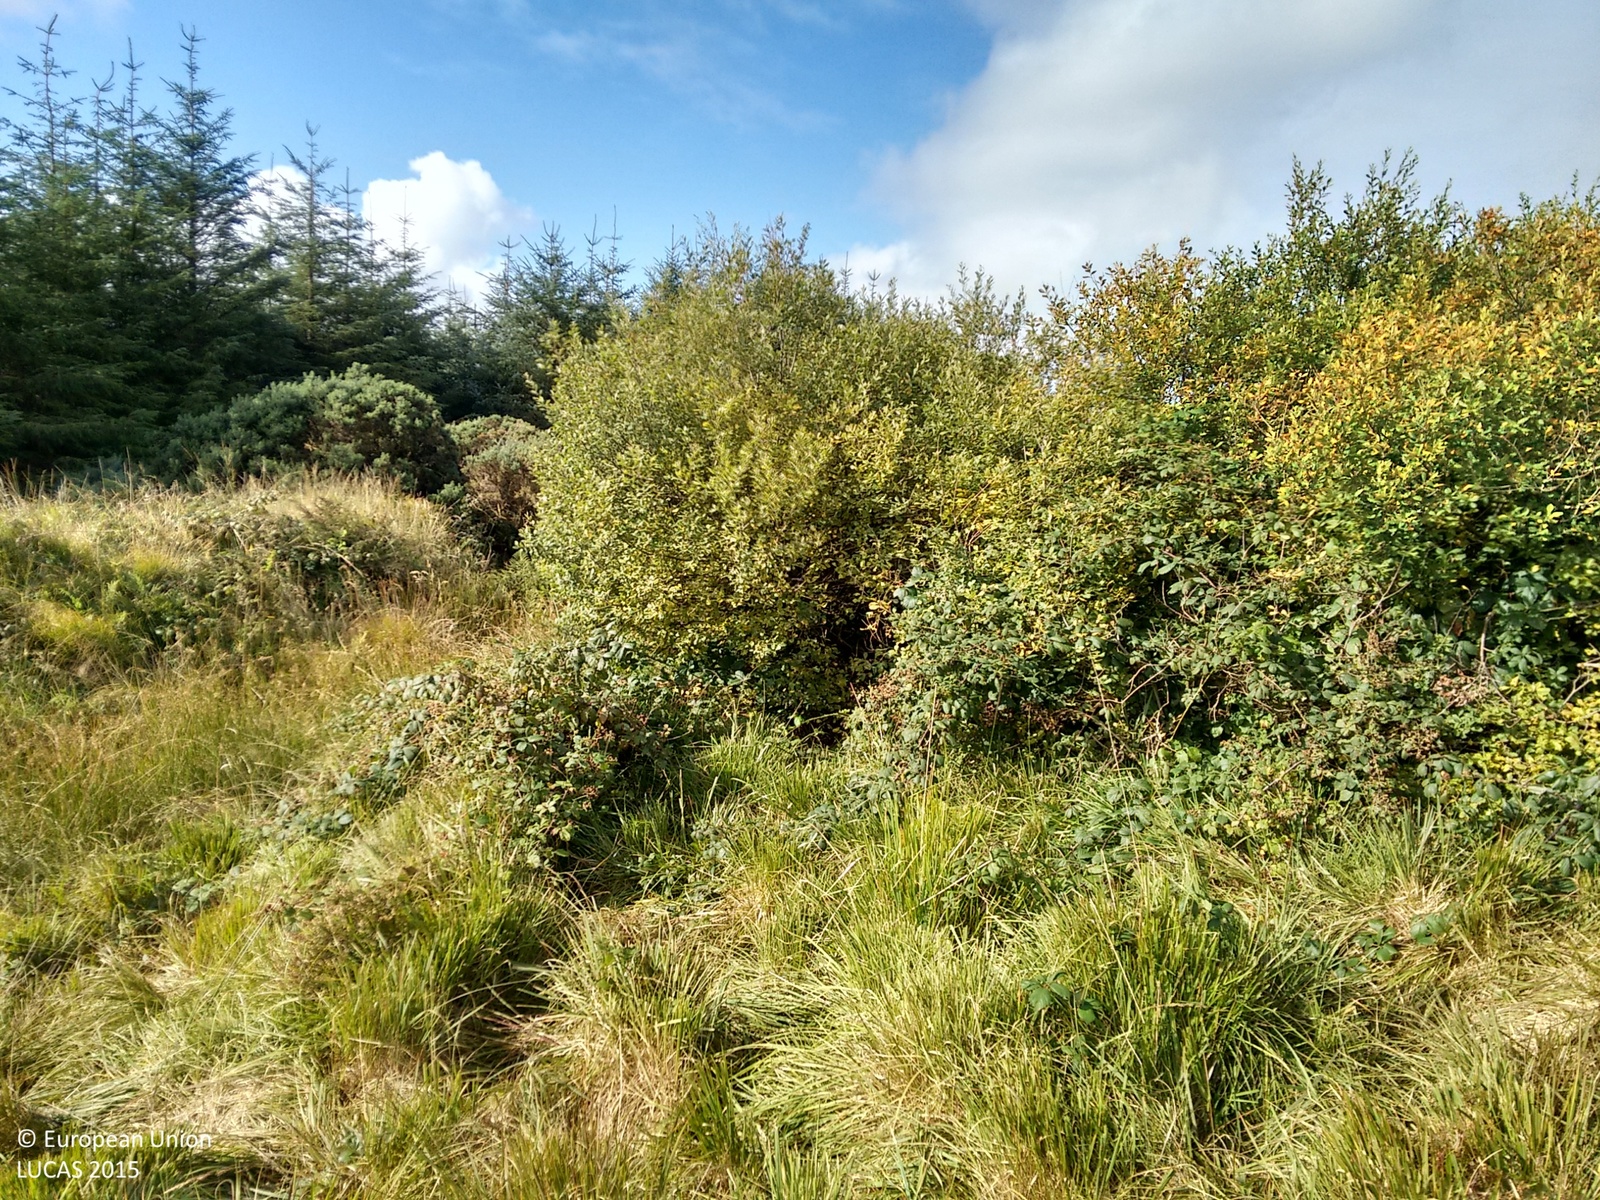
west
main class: Grassland
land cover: Grassland without tree/shrub cover
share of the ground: > 75 %
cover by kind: herbaceous plants 100 %
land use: Agriculture (excluding fallow land and kitchen gardens)
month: September
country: IE
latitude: 52.7568
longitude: -9.3873
